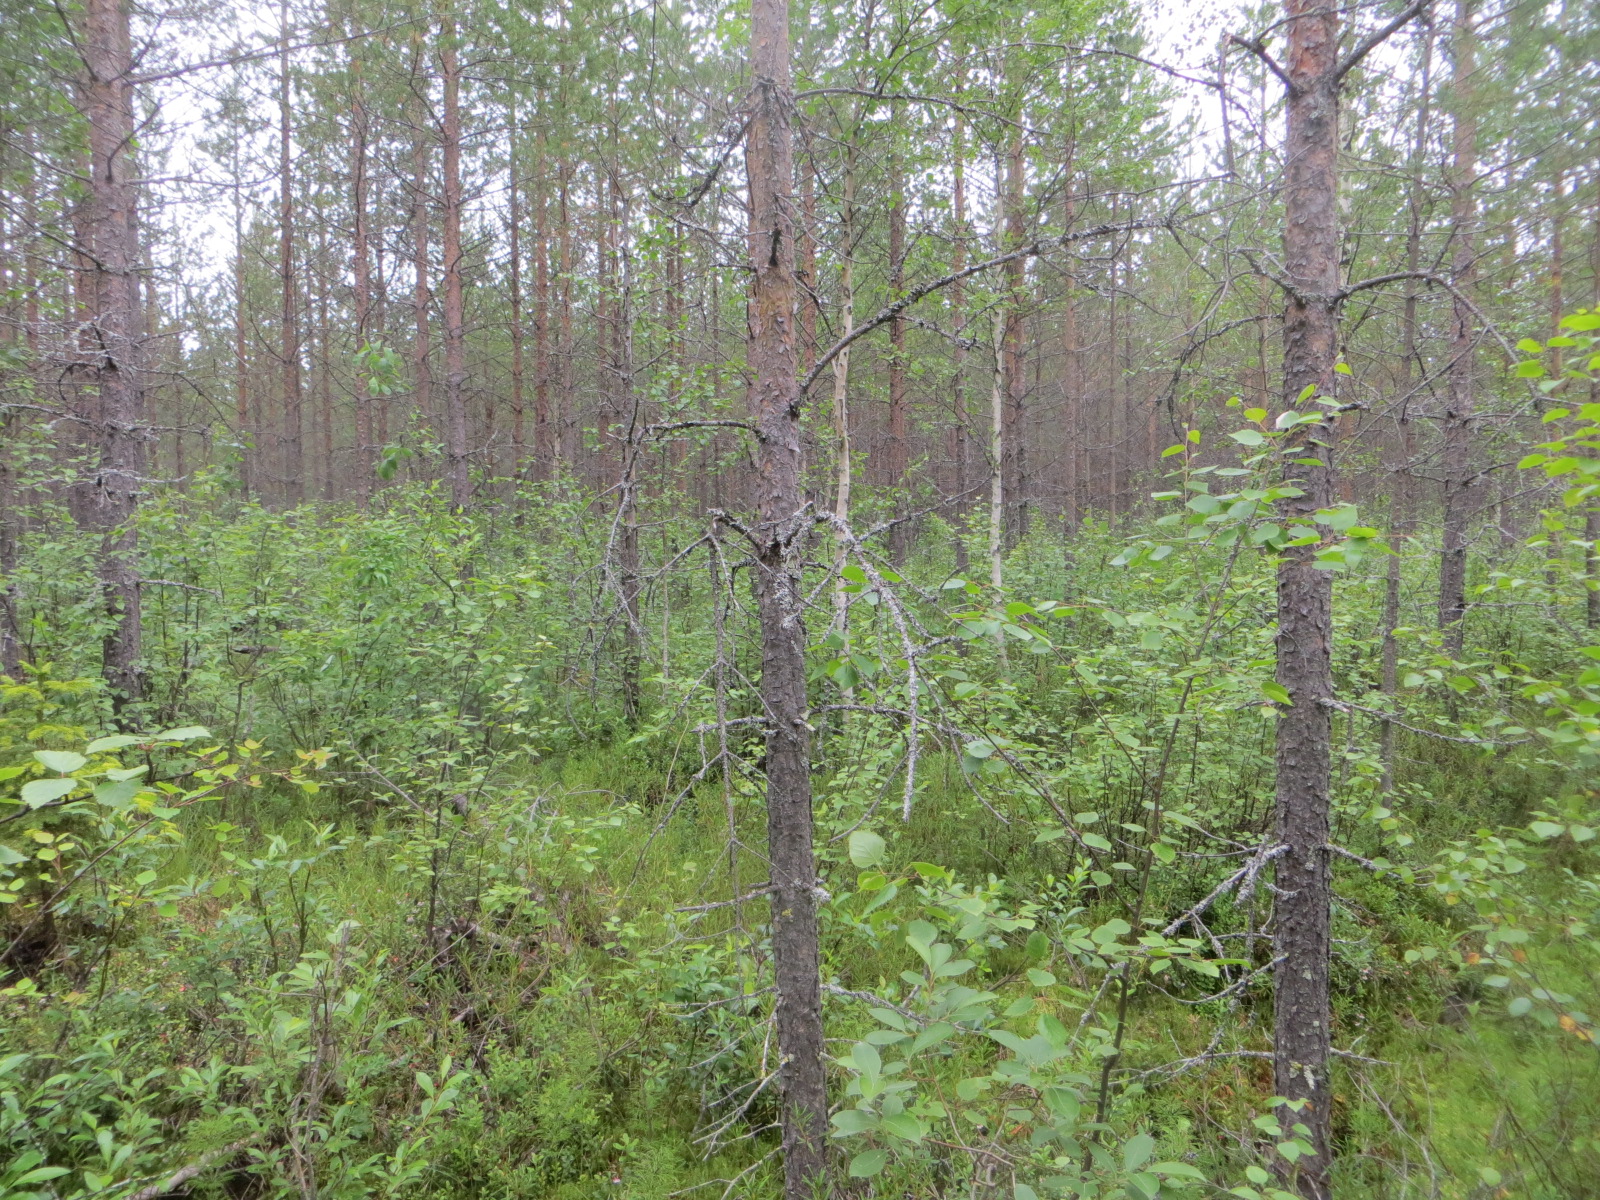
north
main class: Woodland
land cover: Other mixed woodland
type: boreal forest
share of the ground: > 75 %
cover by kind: coniferous forest trees 45 %, broadleaved forest trees 30 %, shrubs 25 %
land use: Forestry
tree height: > 5 m
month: July
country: FI
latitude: 65.8607
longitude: 25.3881
